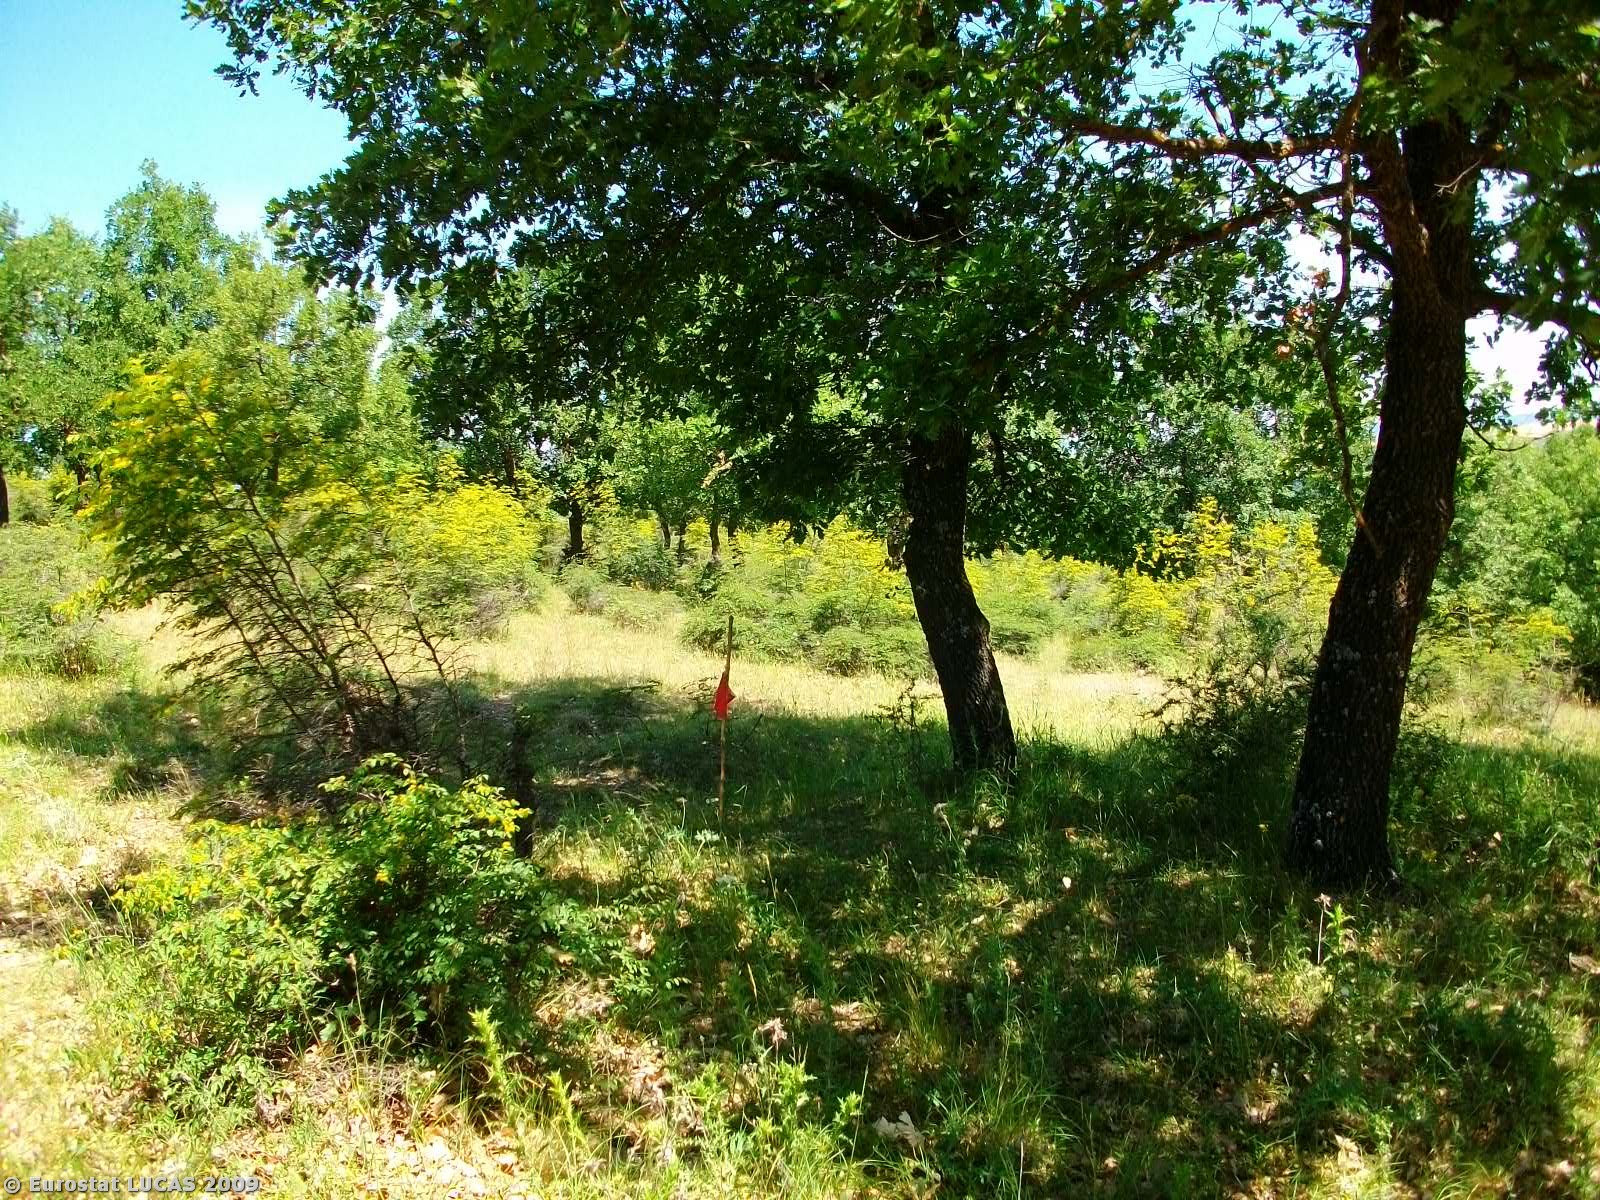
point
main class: Woodland
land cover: Broadleaved woodland
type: thermophilous deciduous forest
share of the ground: 50 - 75 %
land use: Forestry
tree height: > 5 m
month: June
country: GR
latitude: 39.9506
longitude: 21.6803
